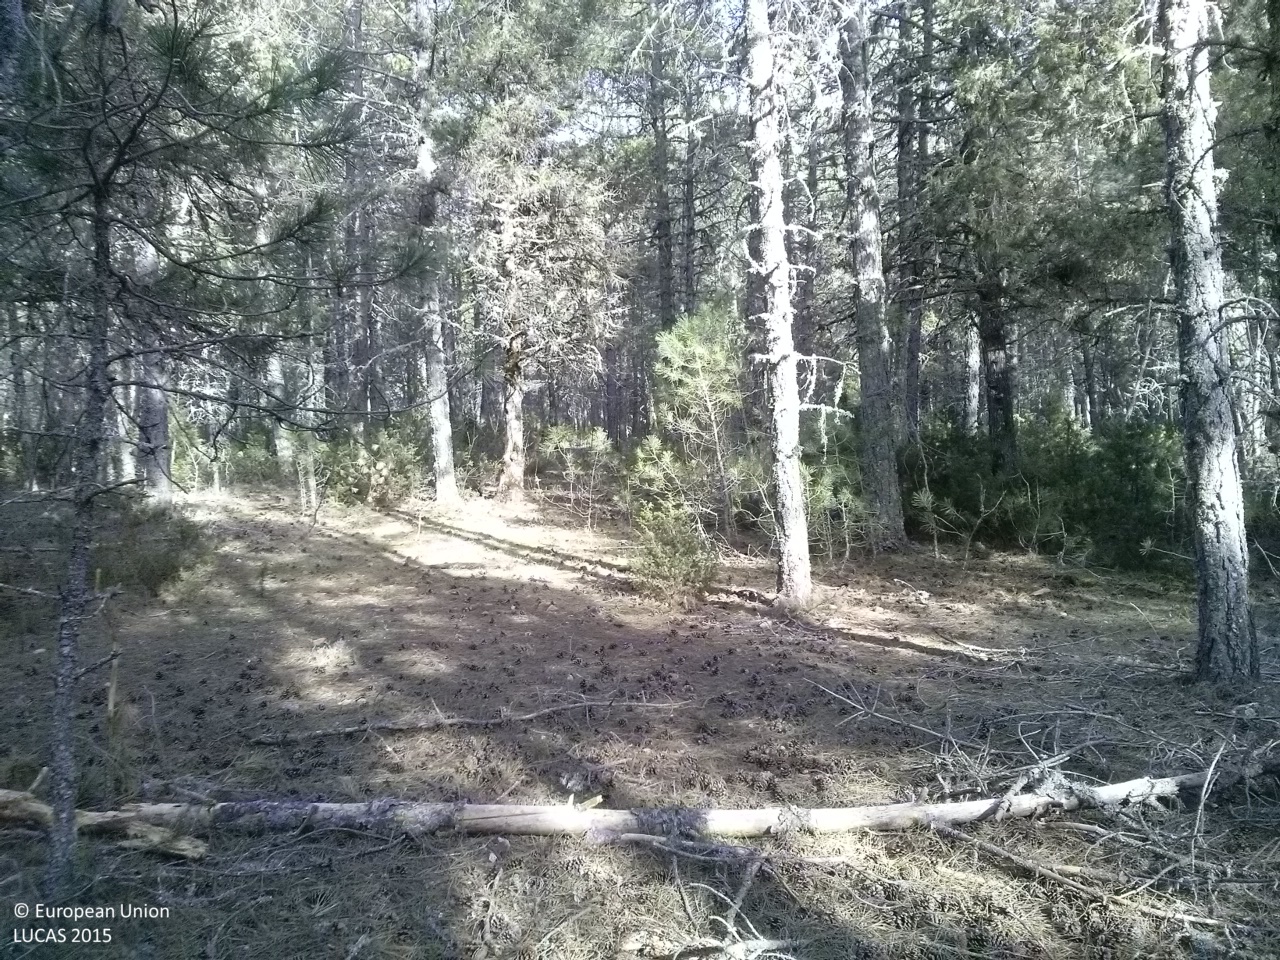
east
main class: Woodland
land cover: Pine dominated coniferous woodland
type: coniferous forest of the mediterranean region
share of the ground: 50 - 75 %
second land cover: Grassland without tree/shrub cover
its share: 10 - 25 %
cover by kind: coniferous forest trees 80 %, herbaceous plants 15 %, shrubs 5 %
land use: Forestry
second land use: Agriculture (excluding fallow land and kitchen gardens)
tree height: > 5 m
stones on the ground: 25 - 50 %
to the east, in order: Pine dominated coniferous woodland; Grassland without tree/shrub cover; Pine dominated coniferous woodland
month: April
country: ES
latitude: 40.1247
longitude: -1.9015
